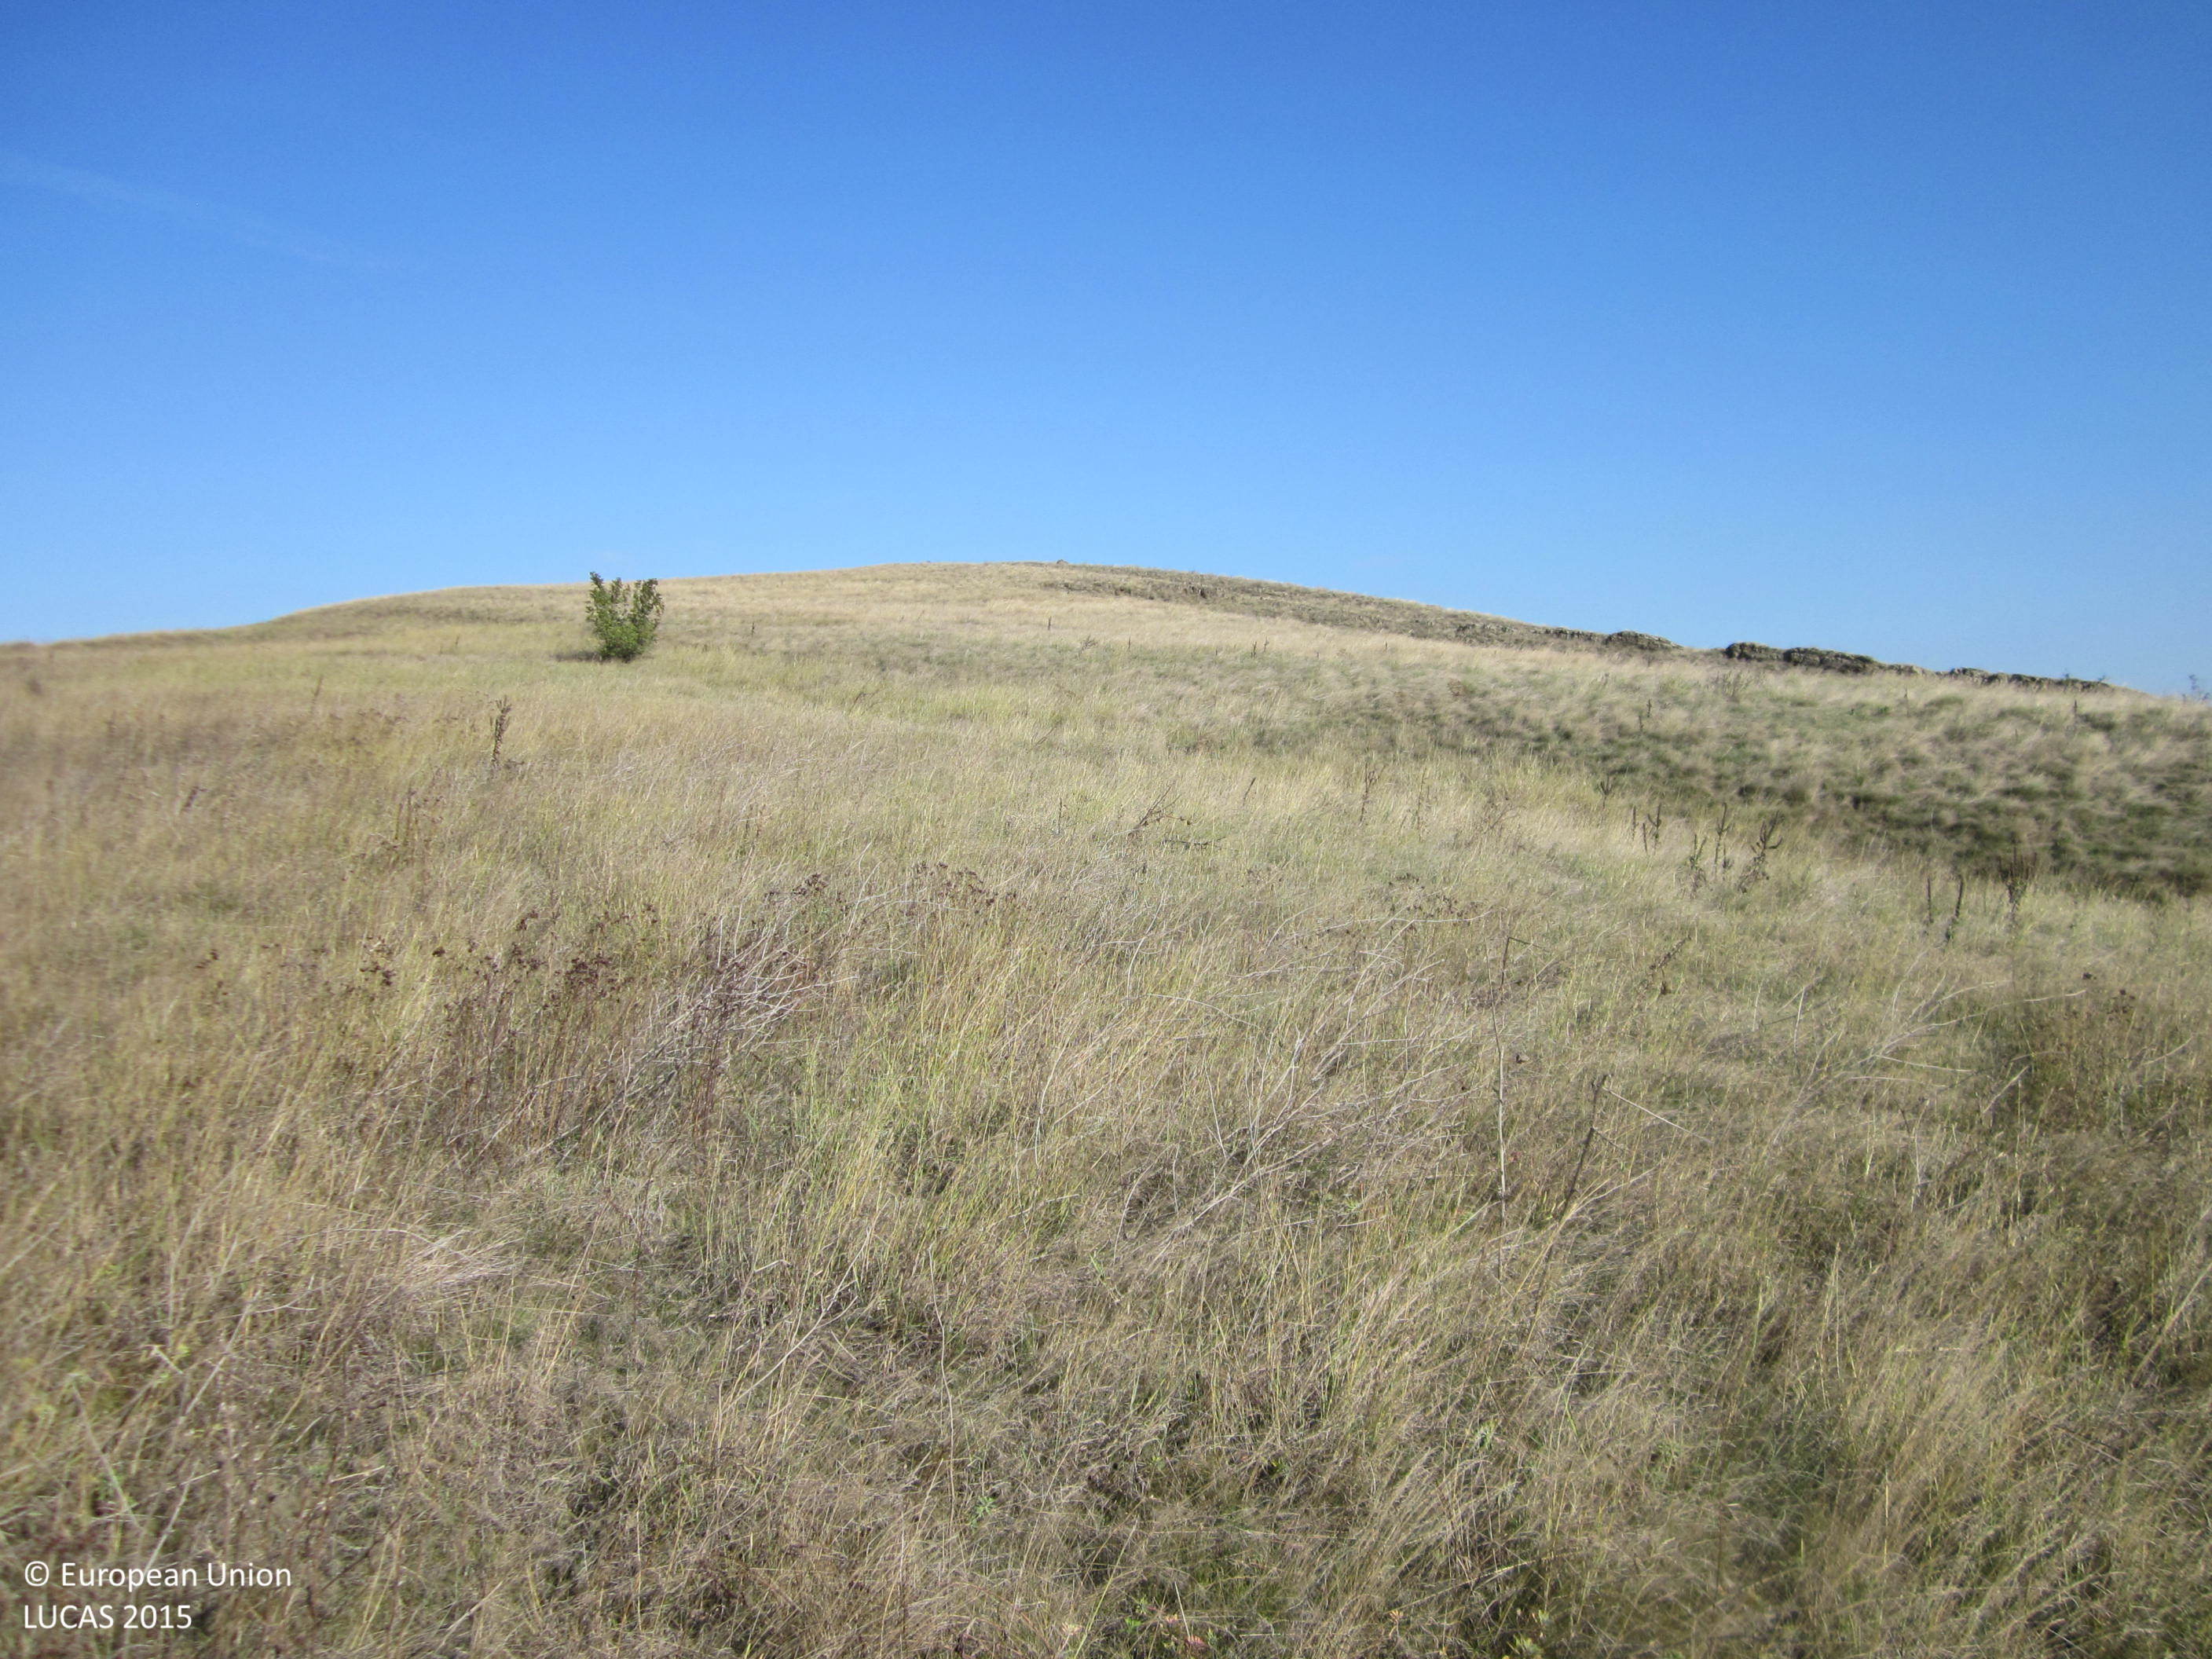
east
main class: Grassland
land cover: Grassland with sparse tree/shrub cover
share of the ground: > 75 %
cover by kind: herbaceous plants 85 %, shrubs 10 %, broadleaved forest trees 5 %
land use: Agriculture (excluding fallow land and kitchen gardens)
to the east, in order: Grassland with sparse tree/shrub cover; Grassland without tree/shrub cover
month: October
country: BG
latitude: 42.6518
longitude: 26.8258
